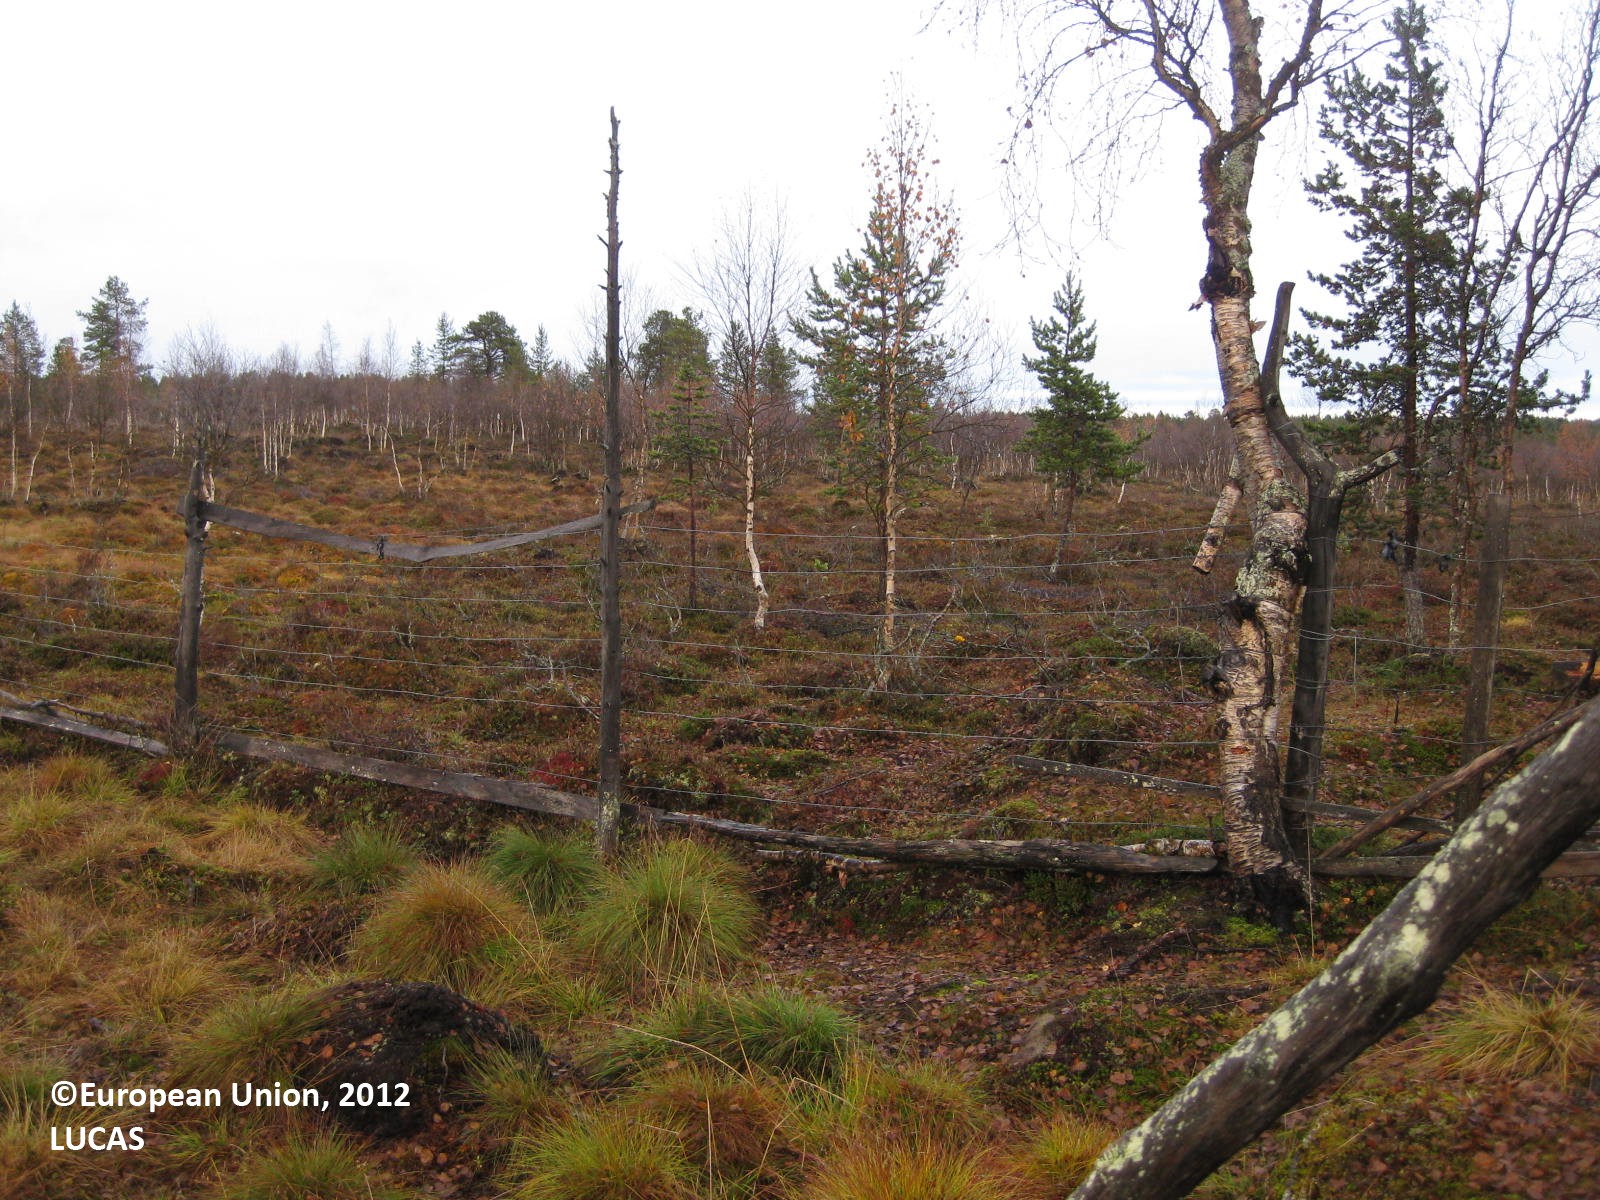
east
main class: Woodland
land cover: Broadleaved woodland
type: boreal forest
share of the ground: 25 - 50 %
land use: Agriculture (excluding fallow land and kitchen gardens)
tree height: > 5 m
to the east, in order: Broadleaved woodland; Fences; Broadleaved woodland; Peatbogs
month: September
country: FI
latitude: 68.4397
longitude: 24.0308
